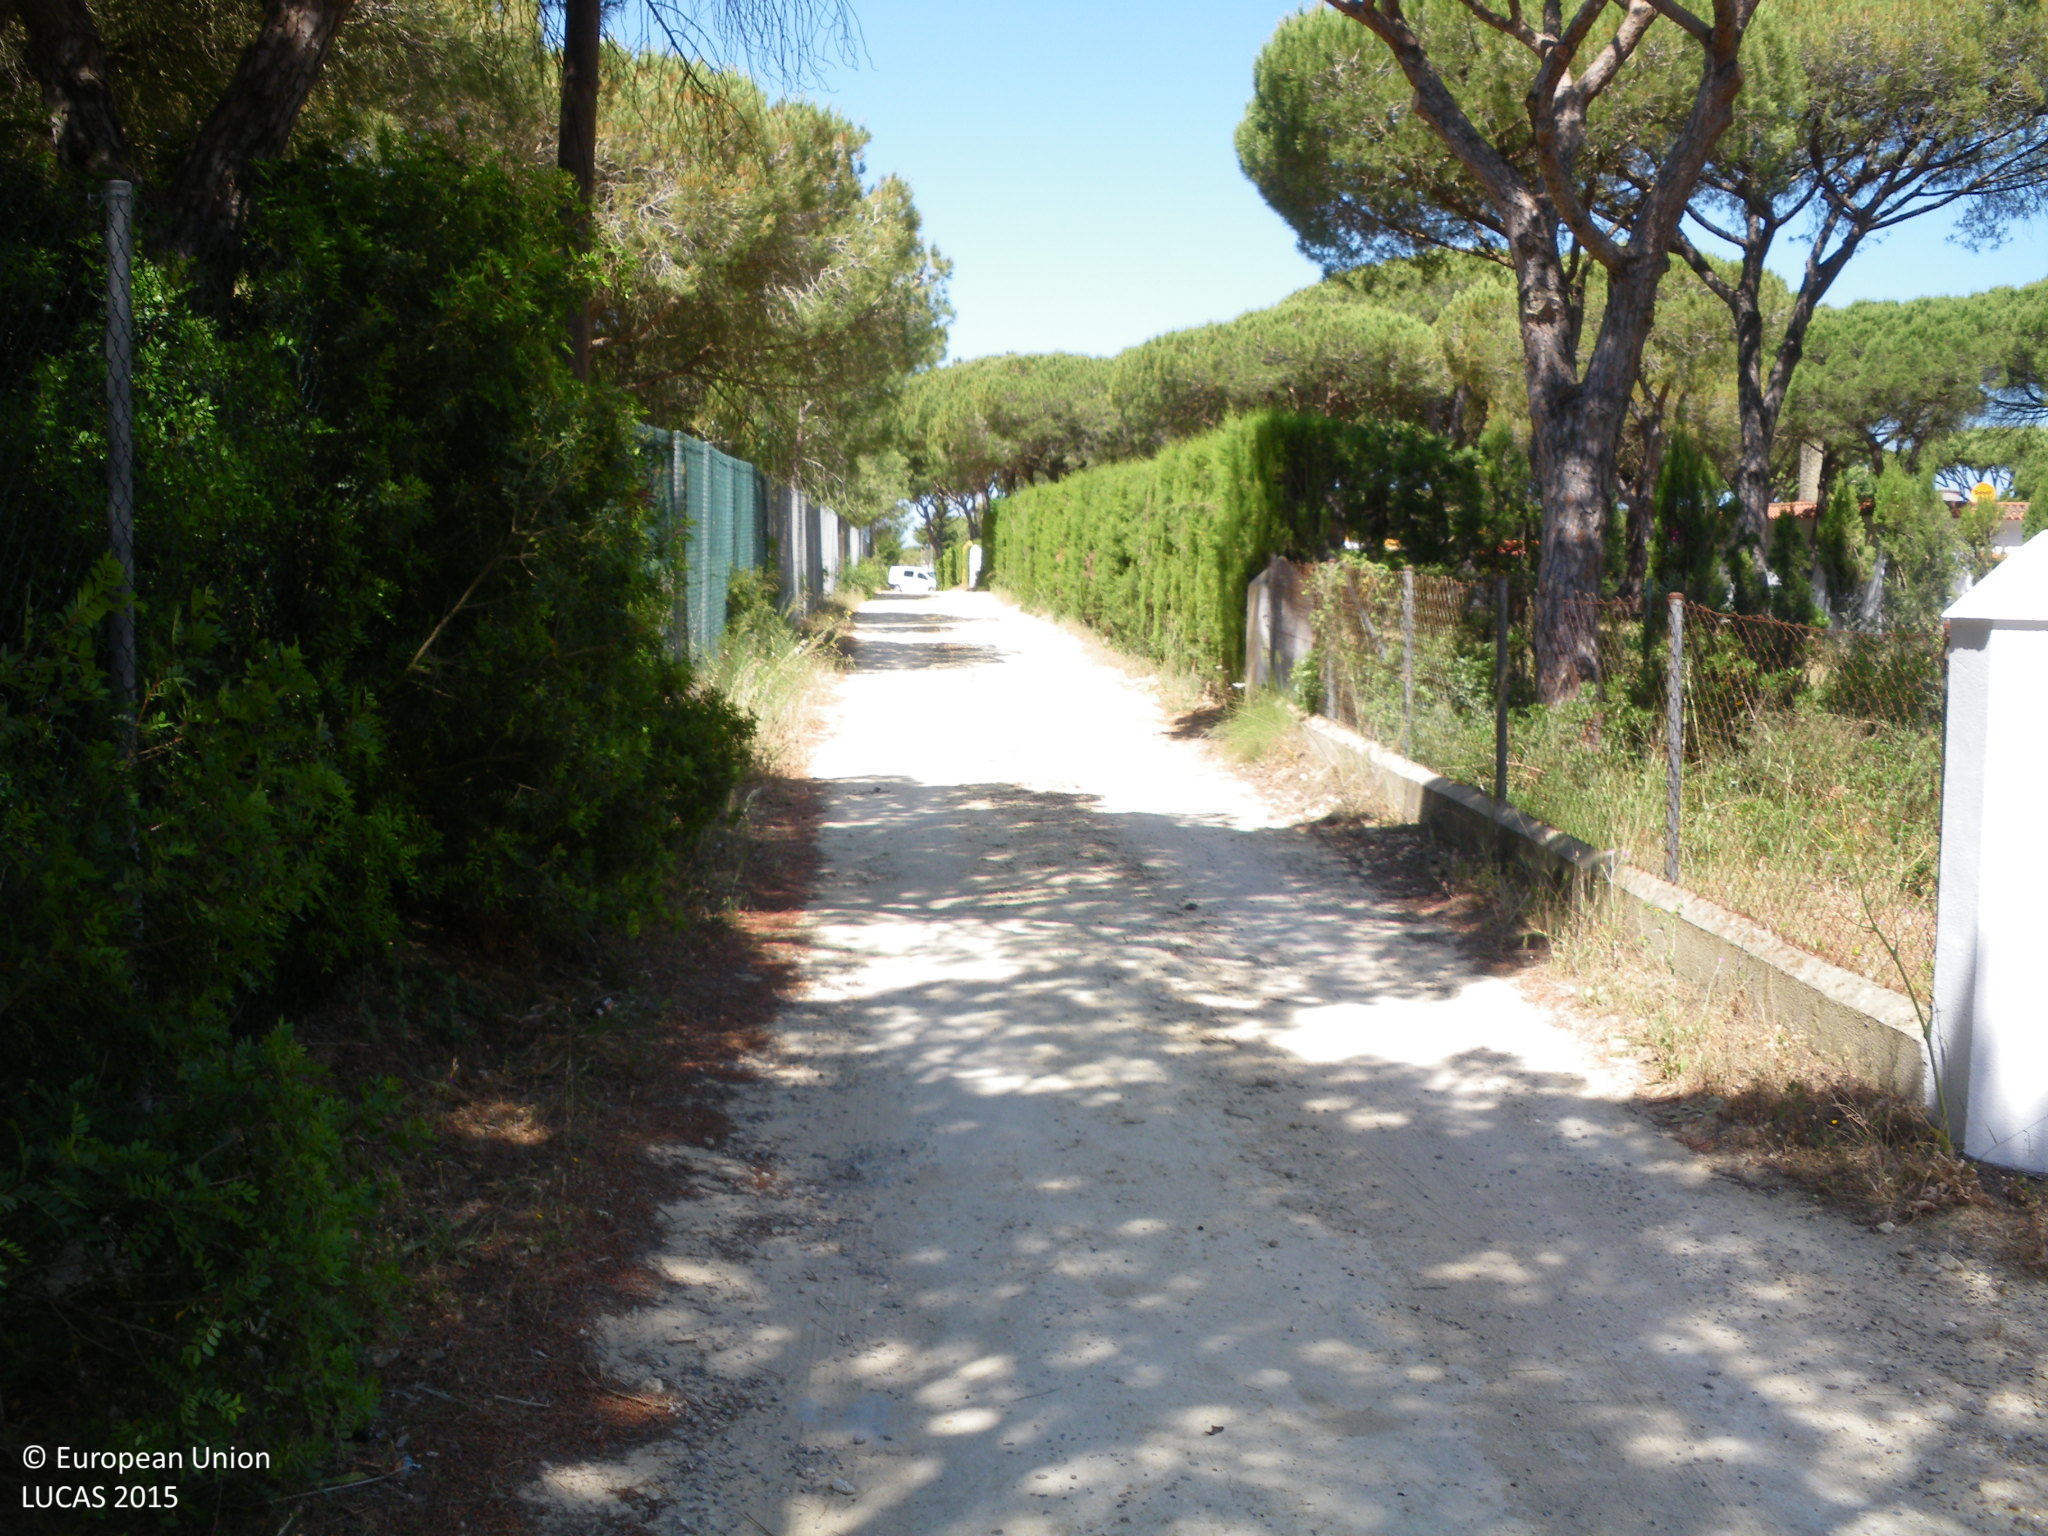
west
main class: Woodland
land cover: Pine dominated coniferous woodland
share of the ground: > 75 %
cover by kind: coniferous forest trees 90 %, shrubs 5 %, herbaceous plants 5 %
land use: Residential
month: May
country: ES
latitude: 36.3110
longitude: -6.0975
